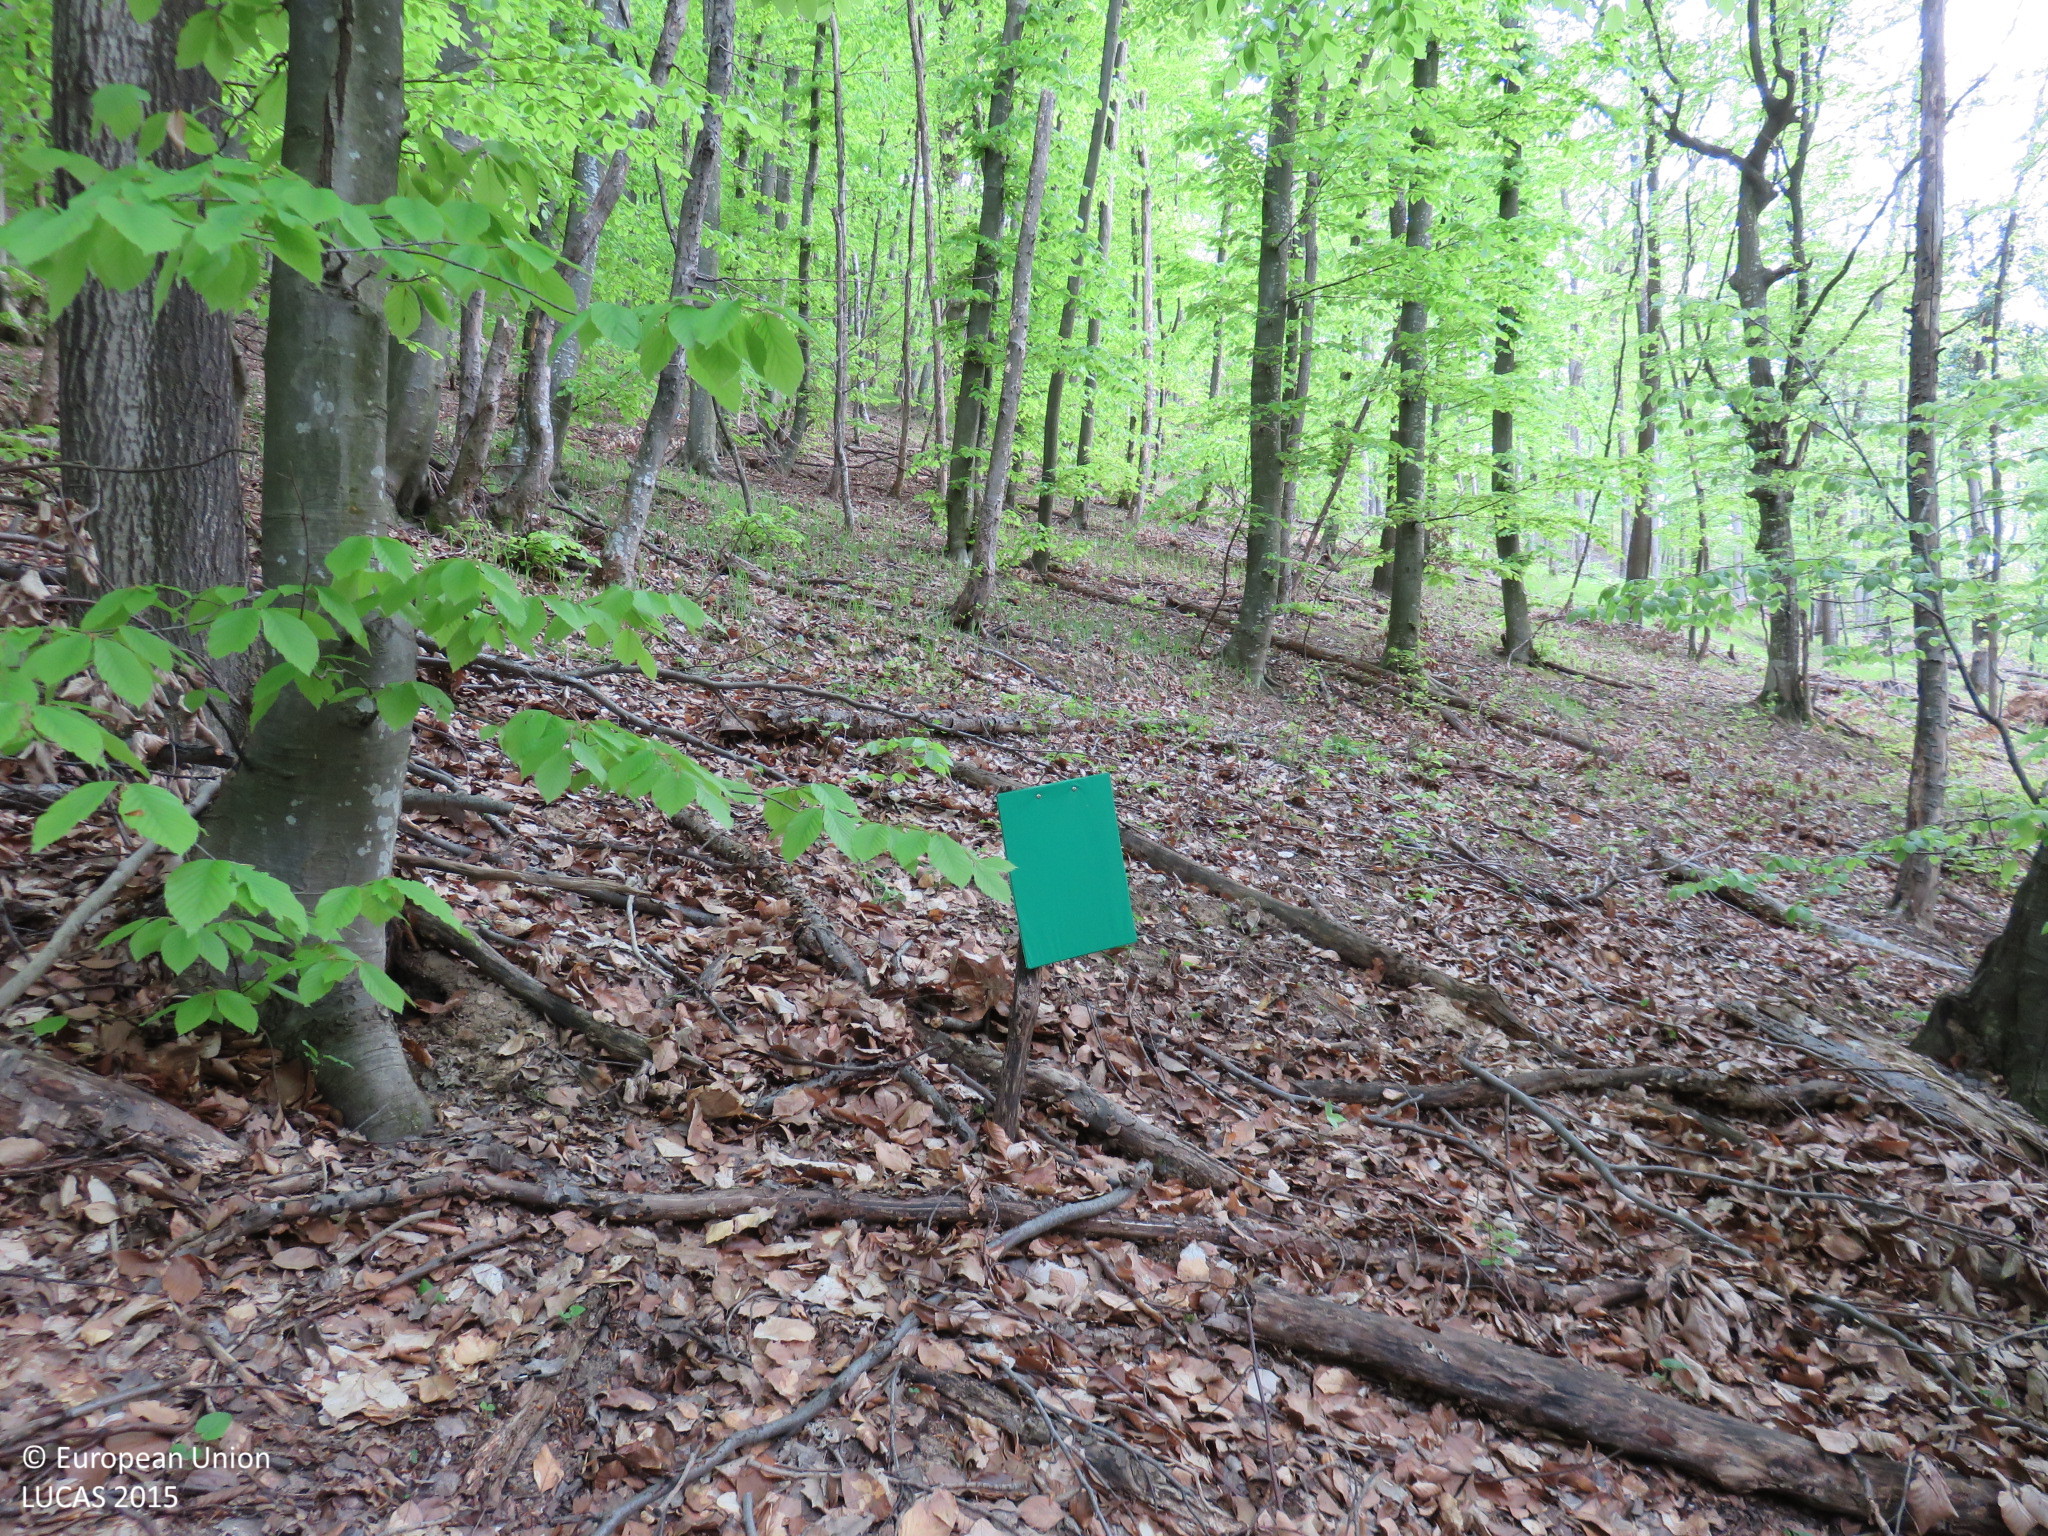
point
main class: Woodland
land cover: Broadleaved woodland
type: beech forest
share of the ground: > 75 %
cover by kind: broadleaved forest trees 80 %, unconsolidated bare surface 20 %
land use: Forestry
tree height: > 5 m
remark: Clear cut
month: April
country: BG
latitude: 43.0187
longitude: 24.8490
